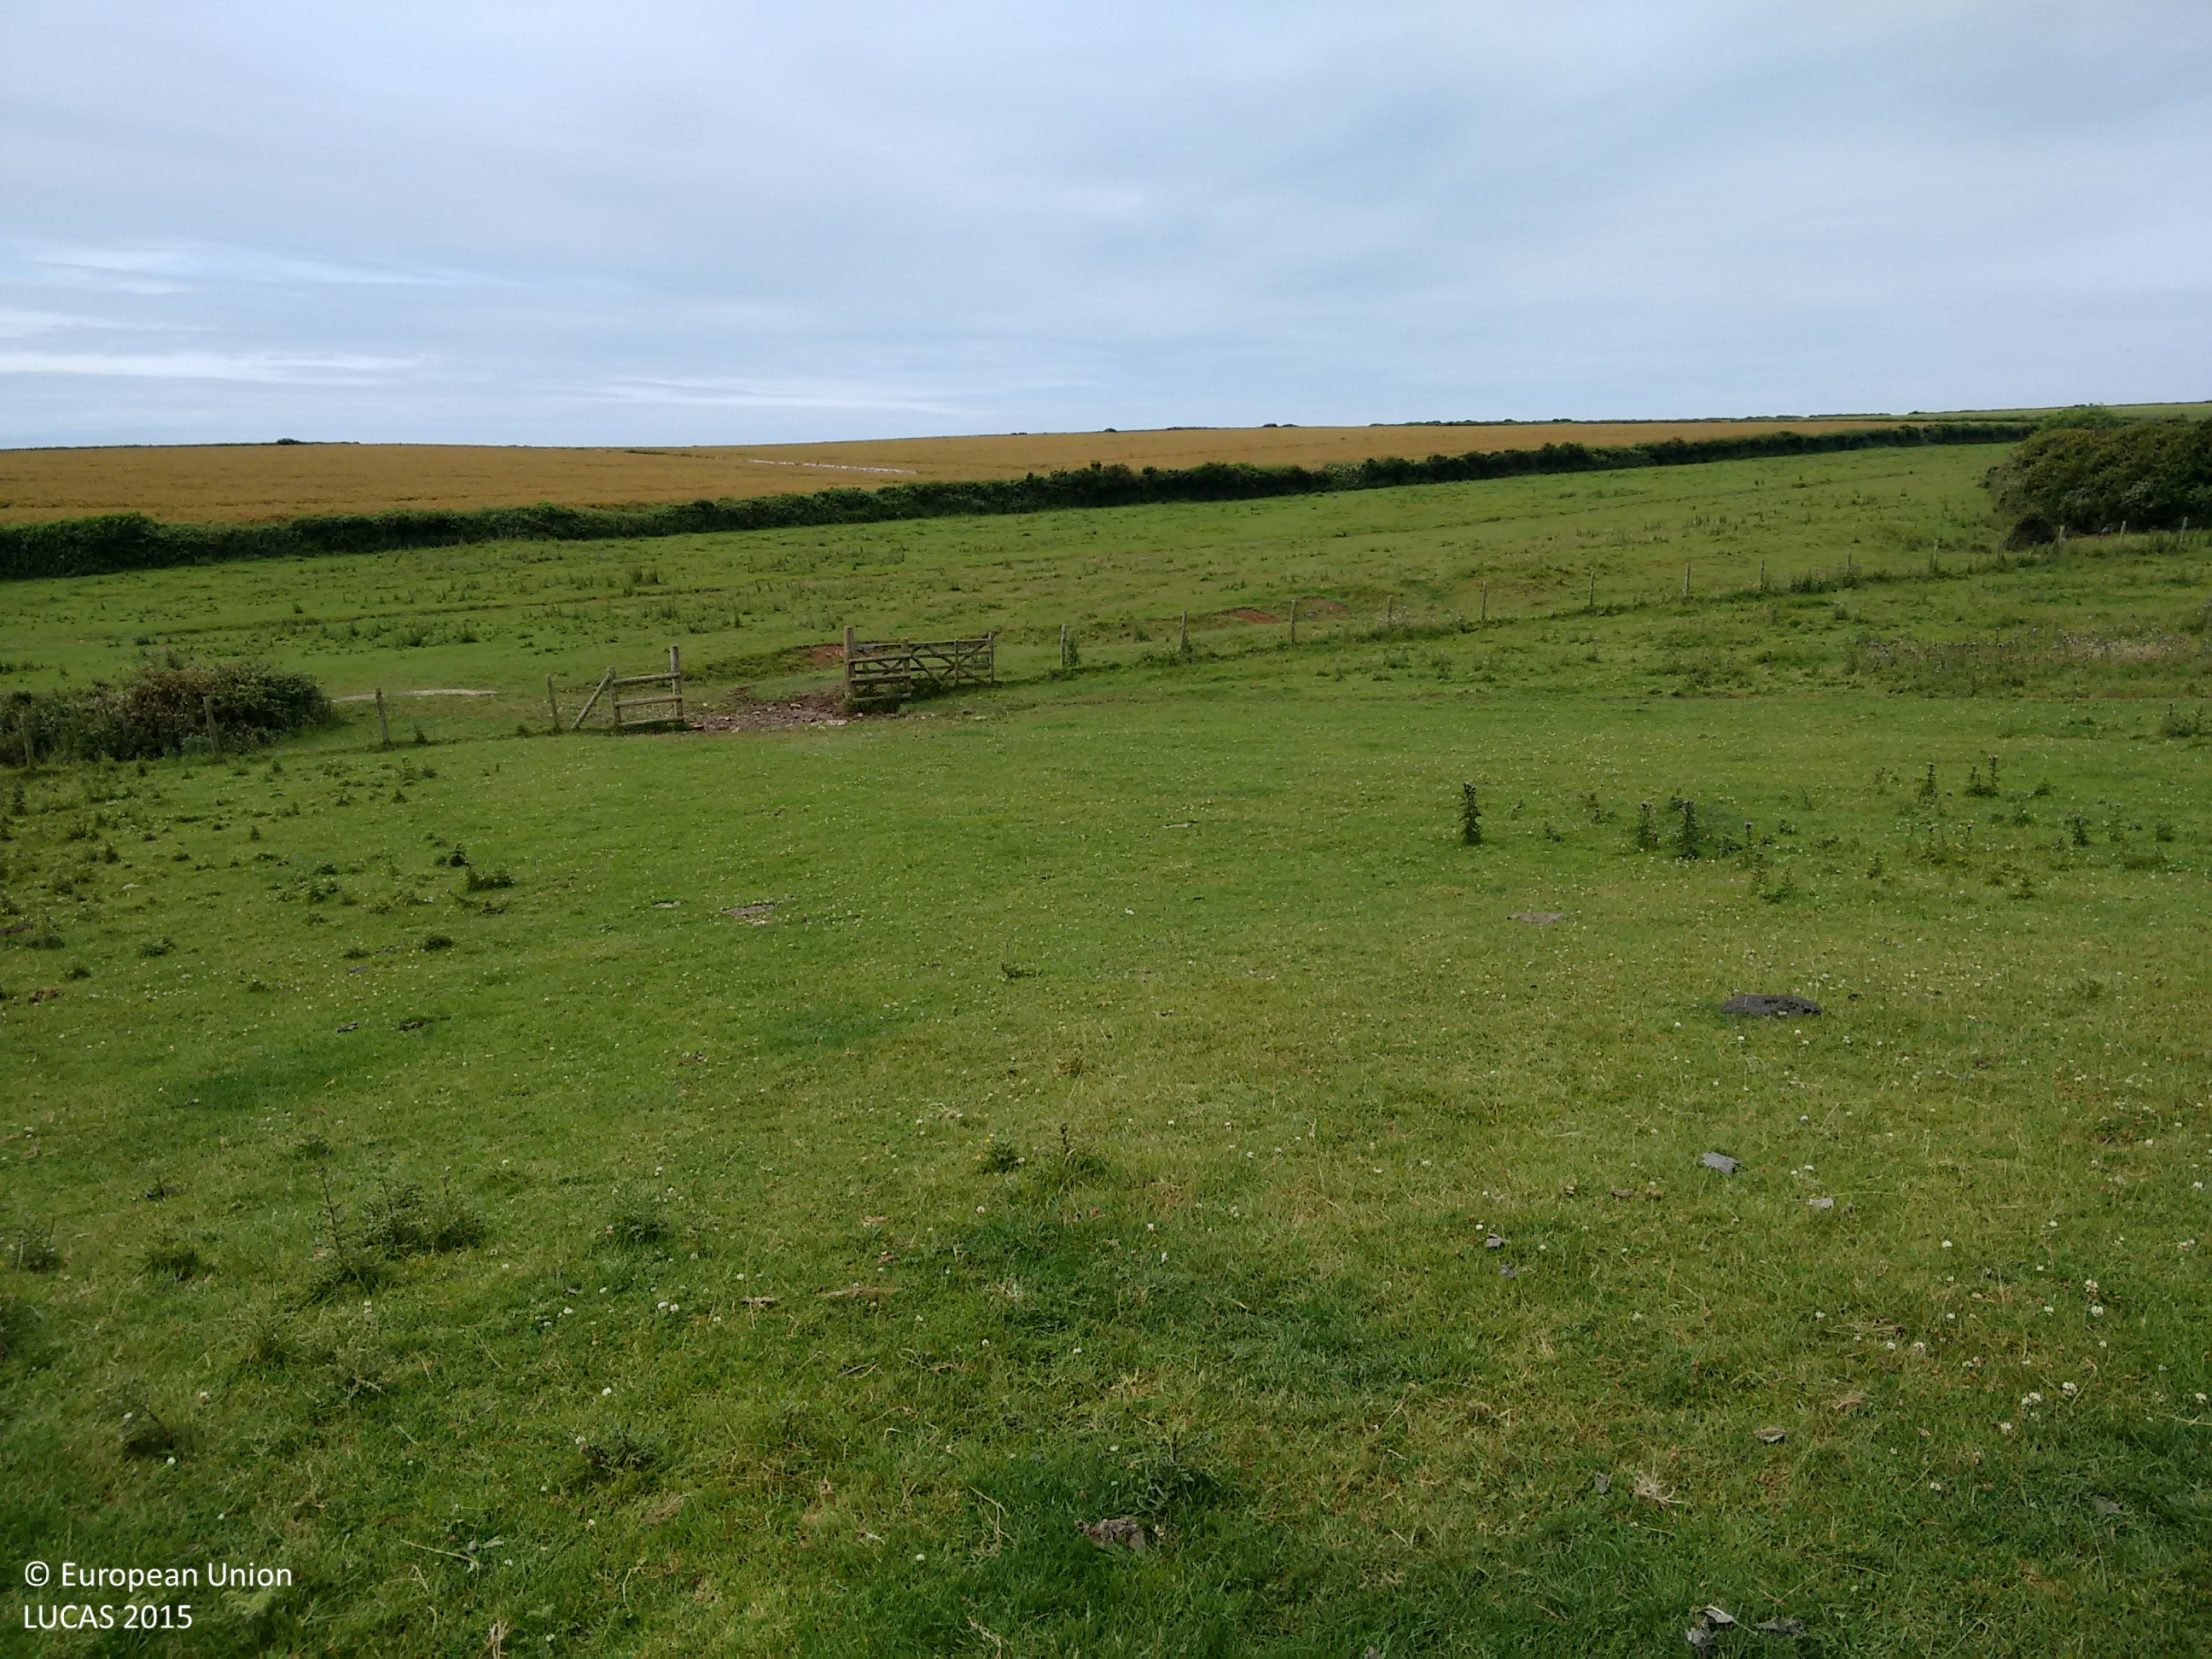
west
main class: Grassland
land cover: Grassland without tree/shrub cover
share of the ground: > 75 %
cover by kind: herbaceous plants 100 %
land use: Agriculture (excluding fallow land and kitchen gardens)
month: July
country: GB
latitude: 51.4125
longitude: -3.5576
